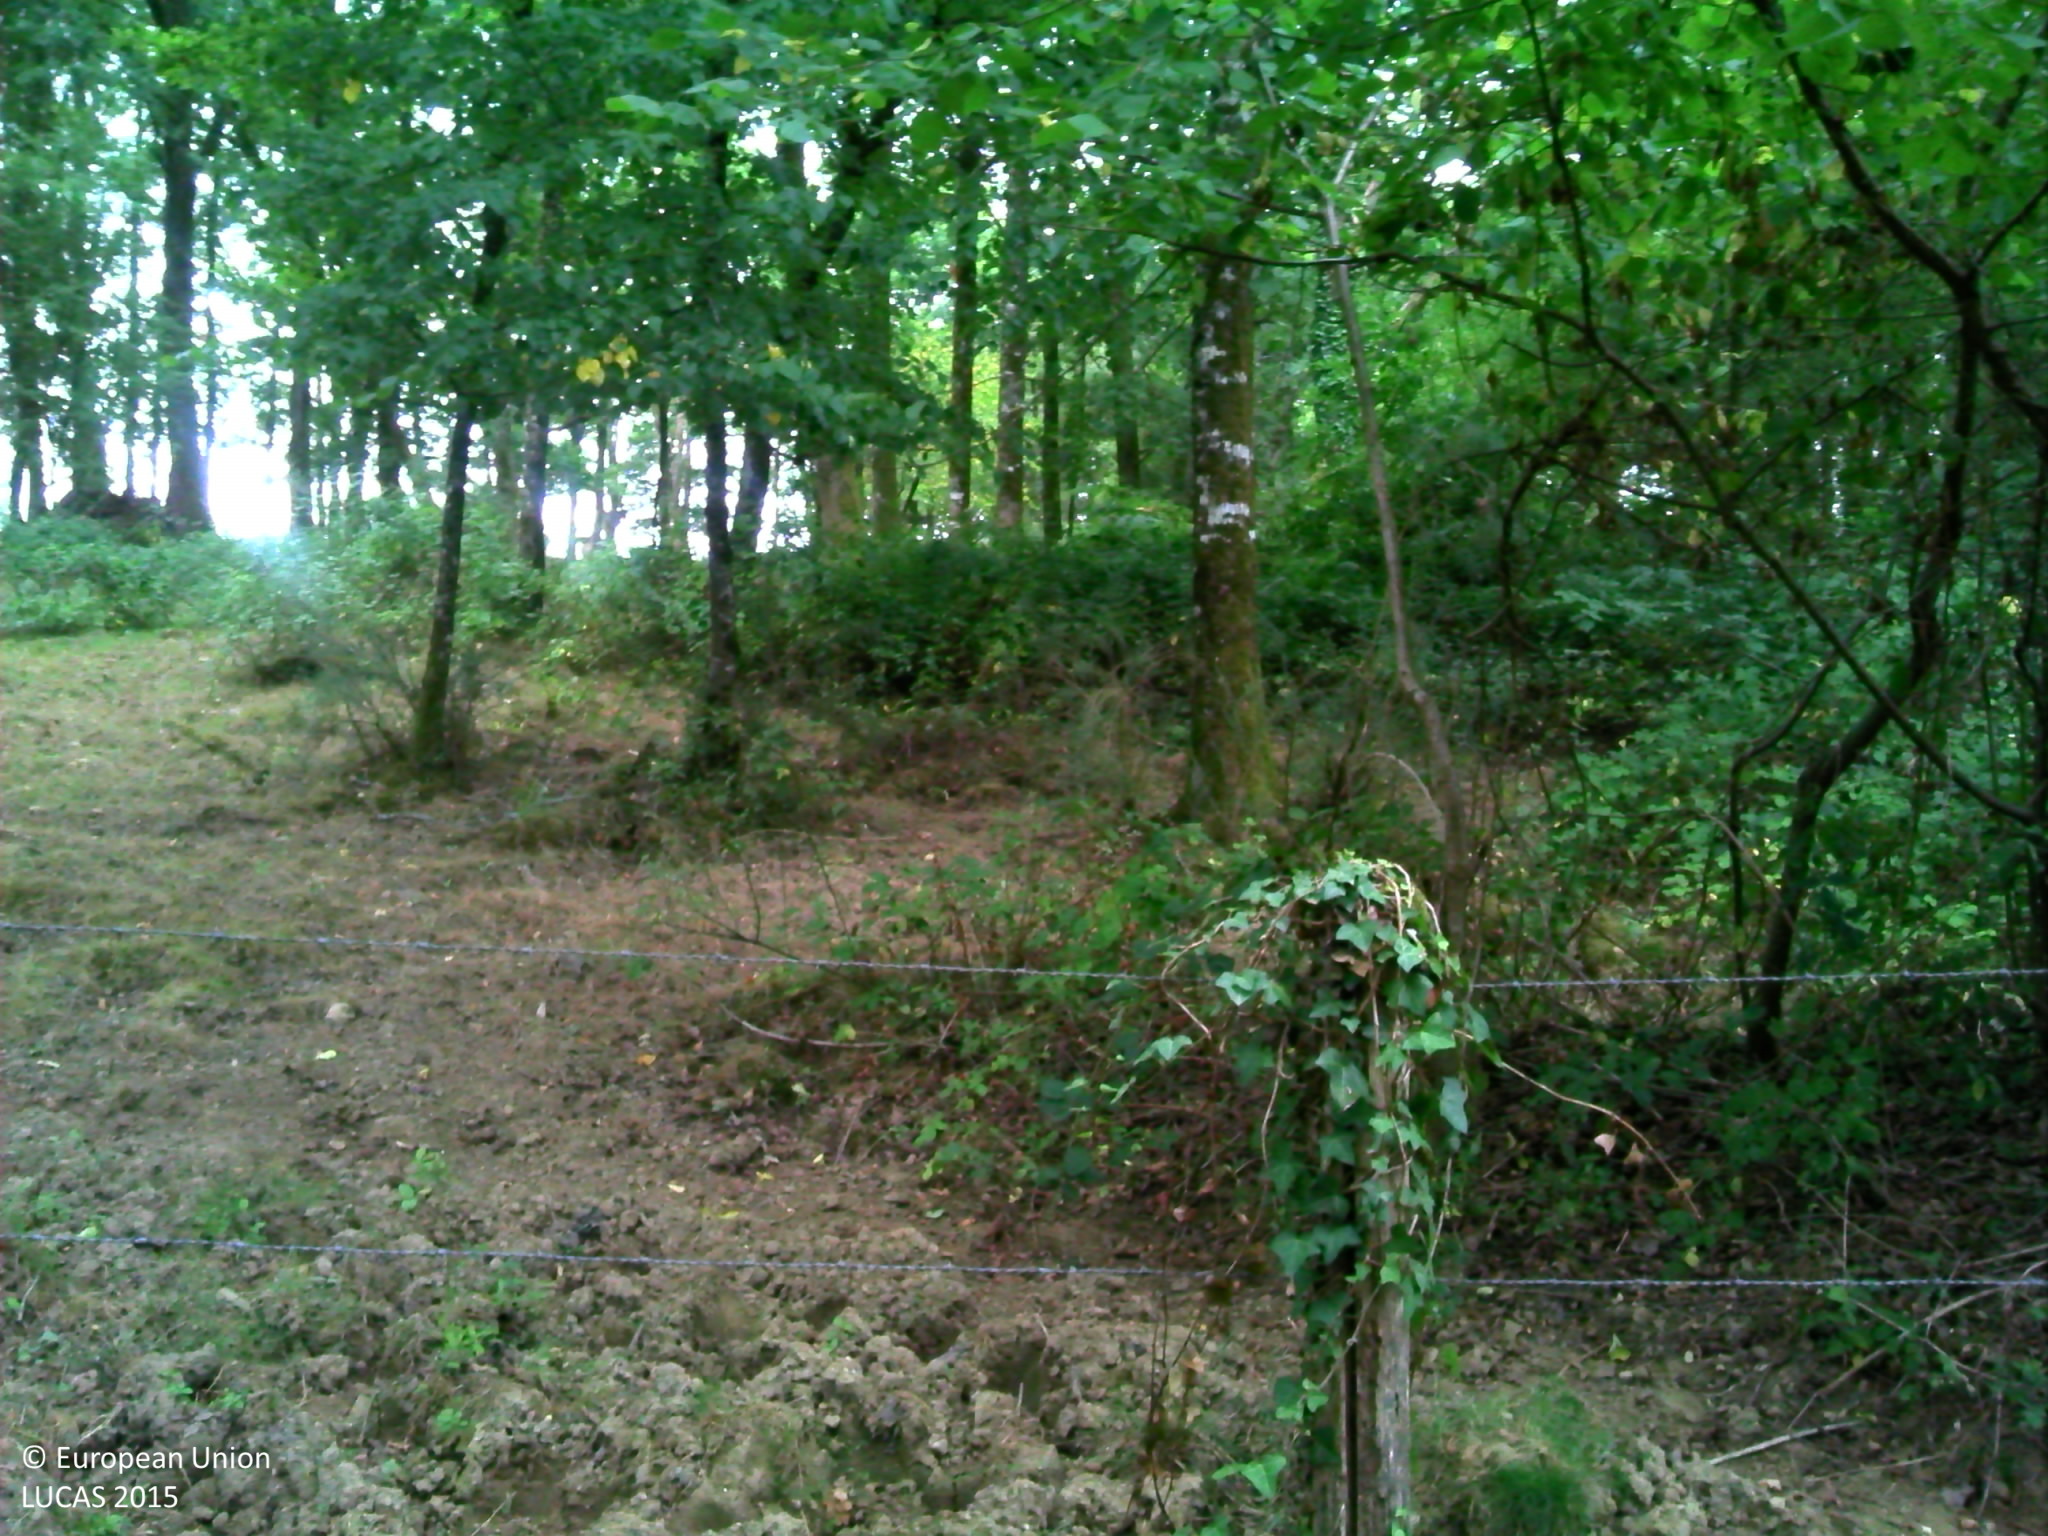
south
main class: Woodland
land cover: Broadleaved woodland
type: mesophytic deciduous forest
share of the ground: > 75 %
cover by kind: broadleaved forest trees 70 %, herbaceous plants 20 %, lichens and mosses 5 %, unconsolidated bare surface 5 %
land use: Forestry
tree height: > 5 m
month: July
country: FR
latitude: 45.5288
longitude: 0.7054
